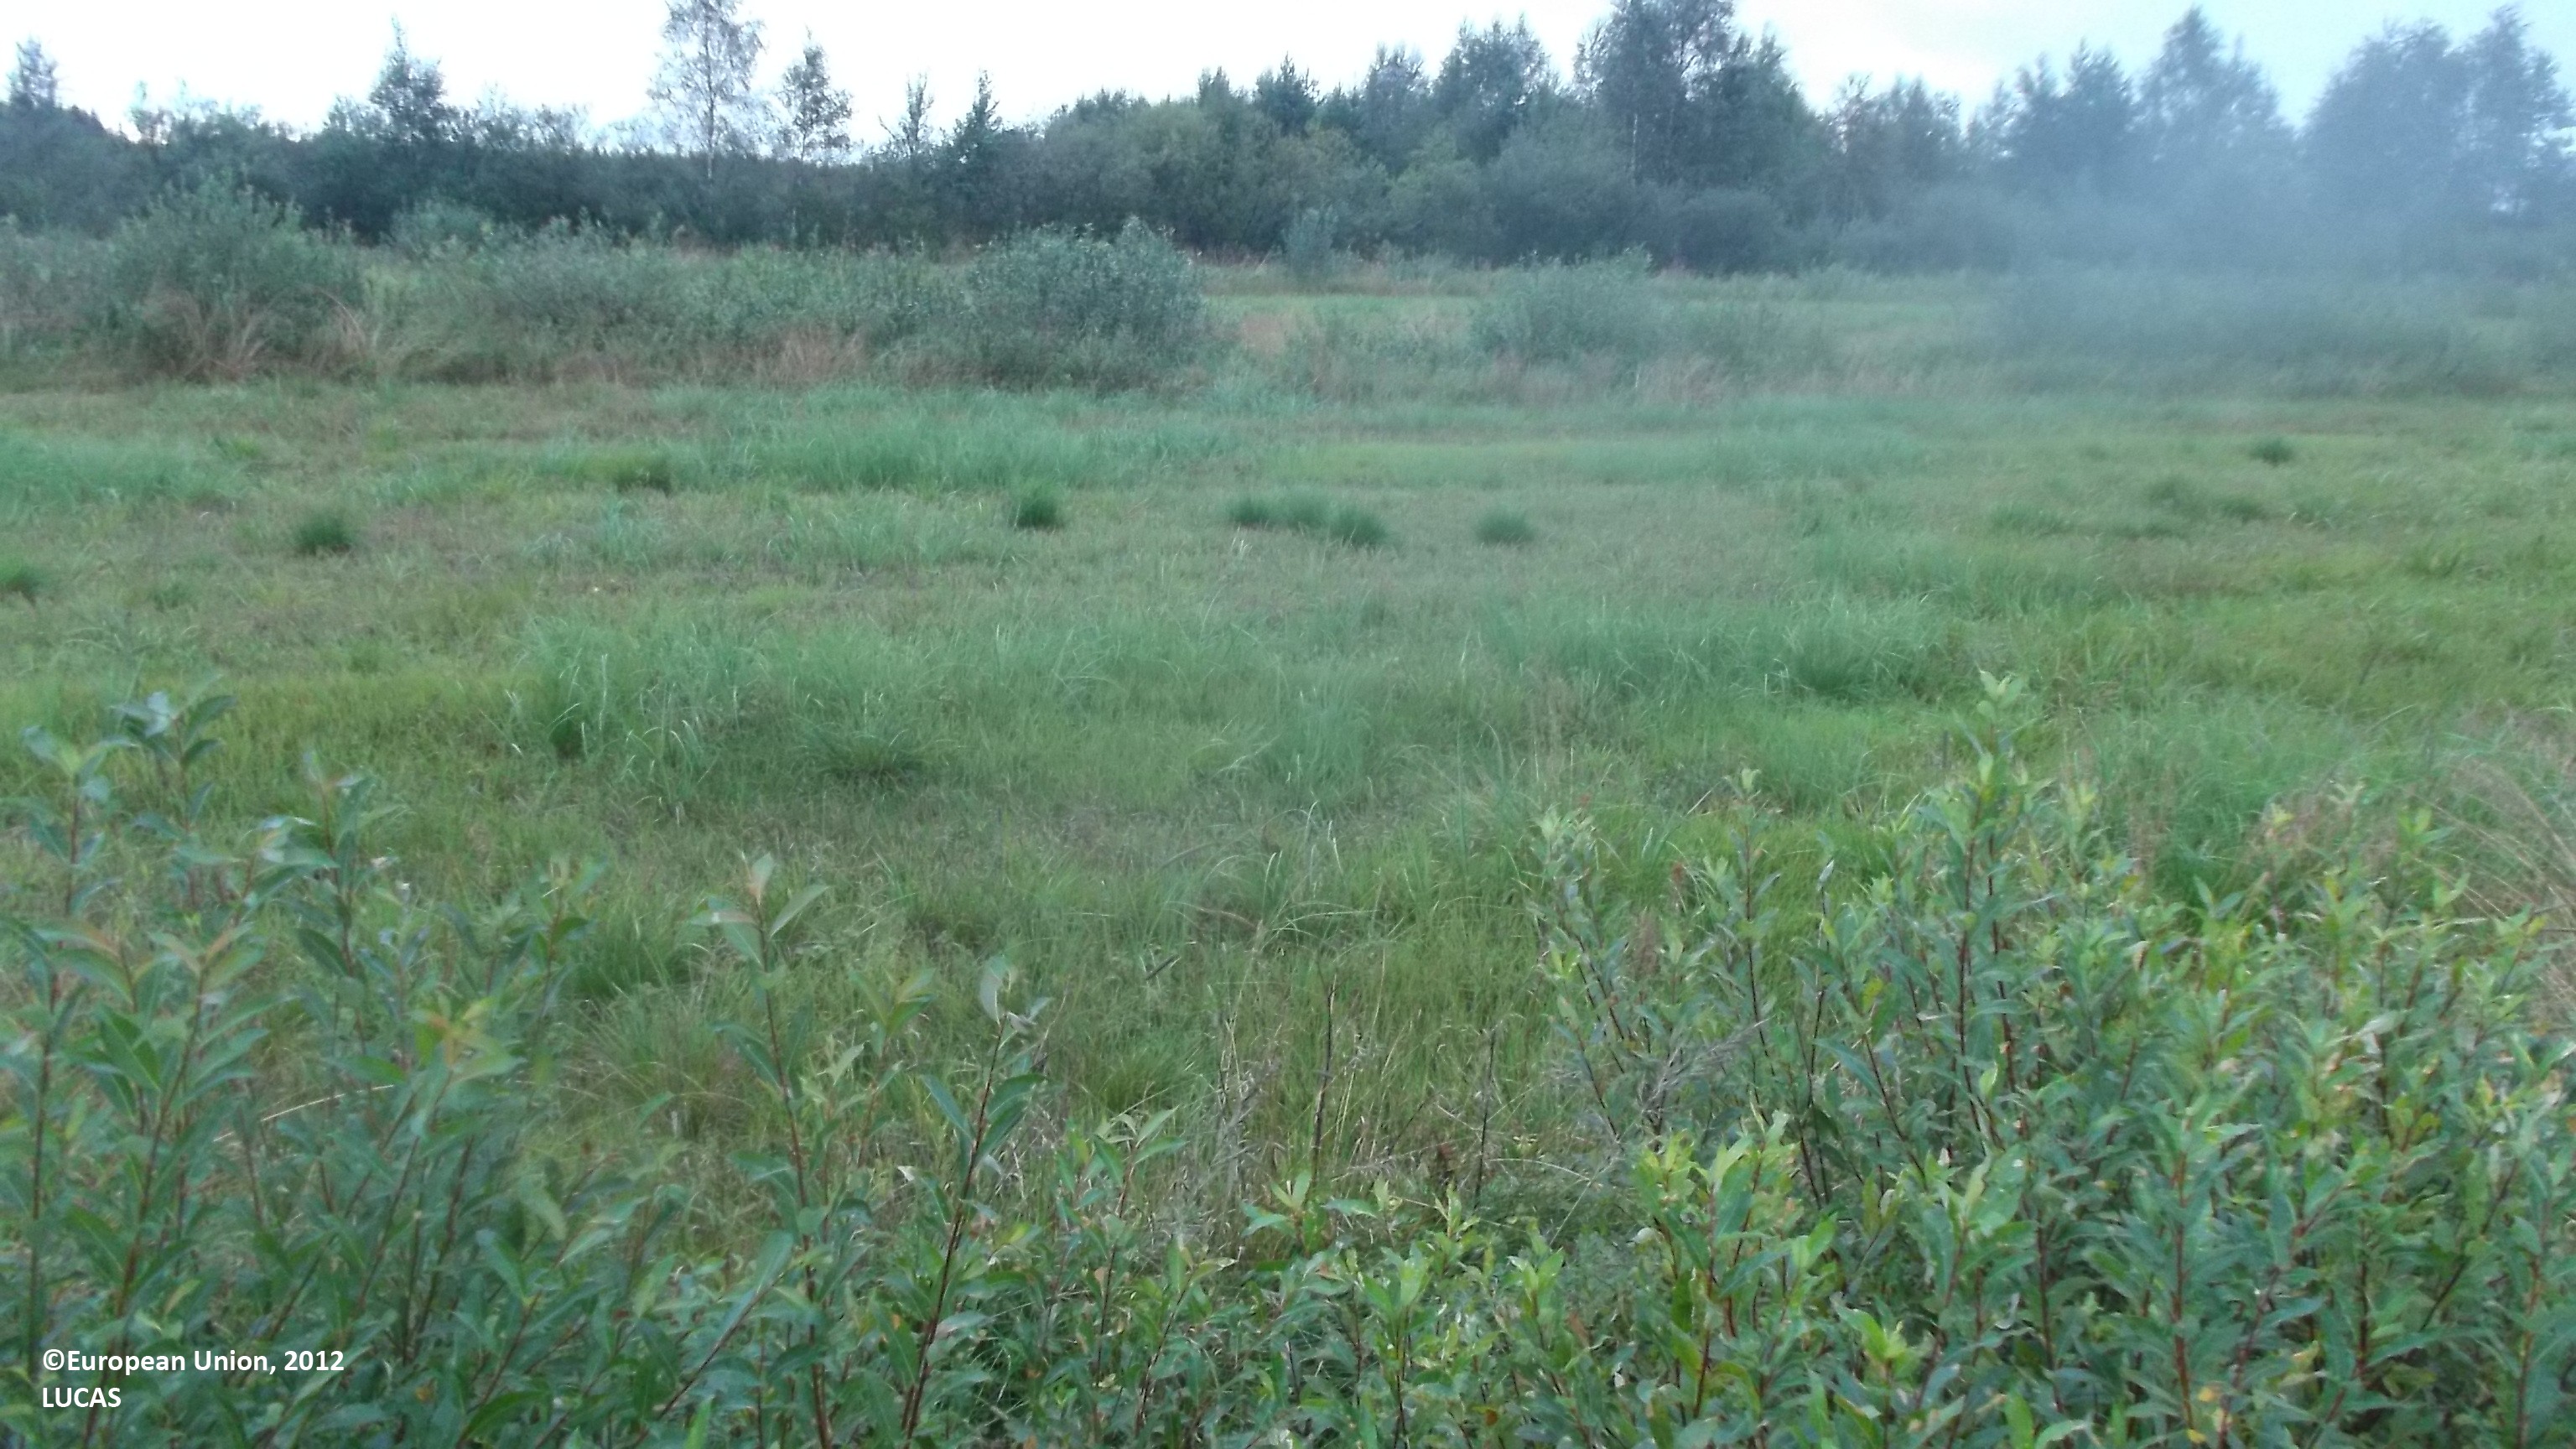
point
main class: Cropland
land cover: Temporary grasslands
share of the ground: > 75 %
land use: Agriculture (excluding fallow land and kitchen gardens)
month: August
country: FI
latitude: 63.2328
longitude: 24.4714
